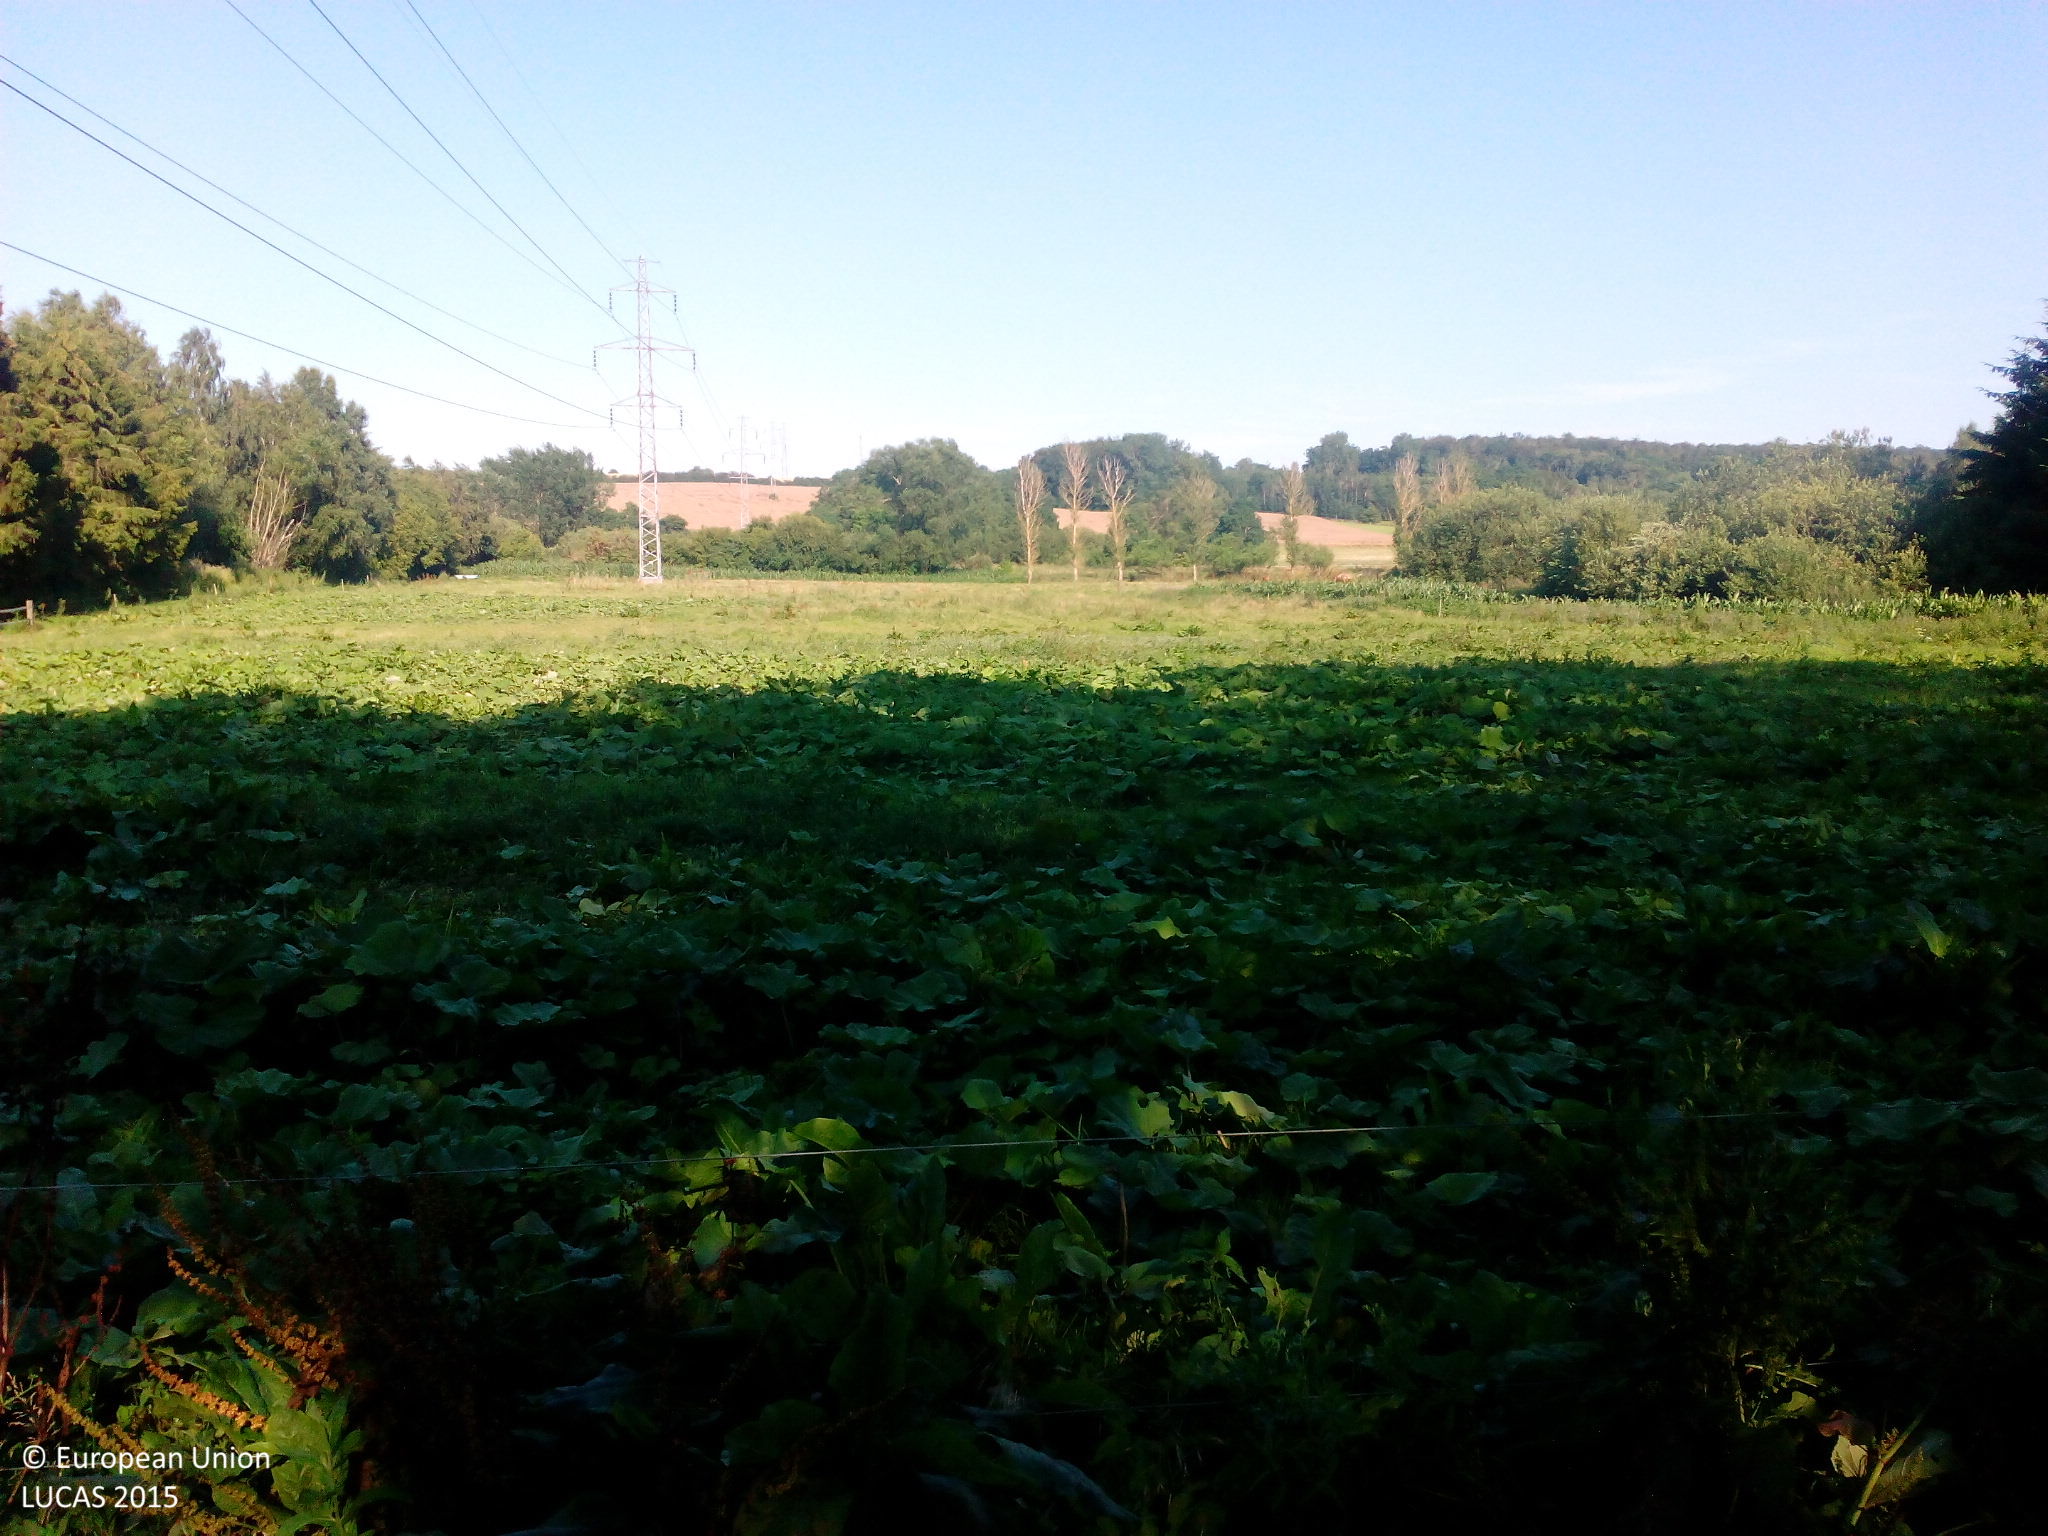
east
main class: Woodland
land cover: Spruce dominated coniferous woodland
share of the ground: > 75 %
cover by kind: coniferous forest trees 80 %, broadleaved forest trees 20 %
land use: Semi-natural and natural areas not in use
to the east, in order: Spruce dominated coniferous woodland; Tracks; Shruby margins; Fences; Grassland without tree/shrub cover; Fences; Maize; Broadleaved woodland; Maize
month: August
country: DK
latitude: 55.6358
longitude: 11.7935
